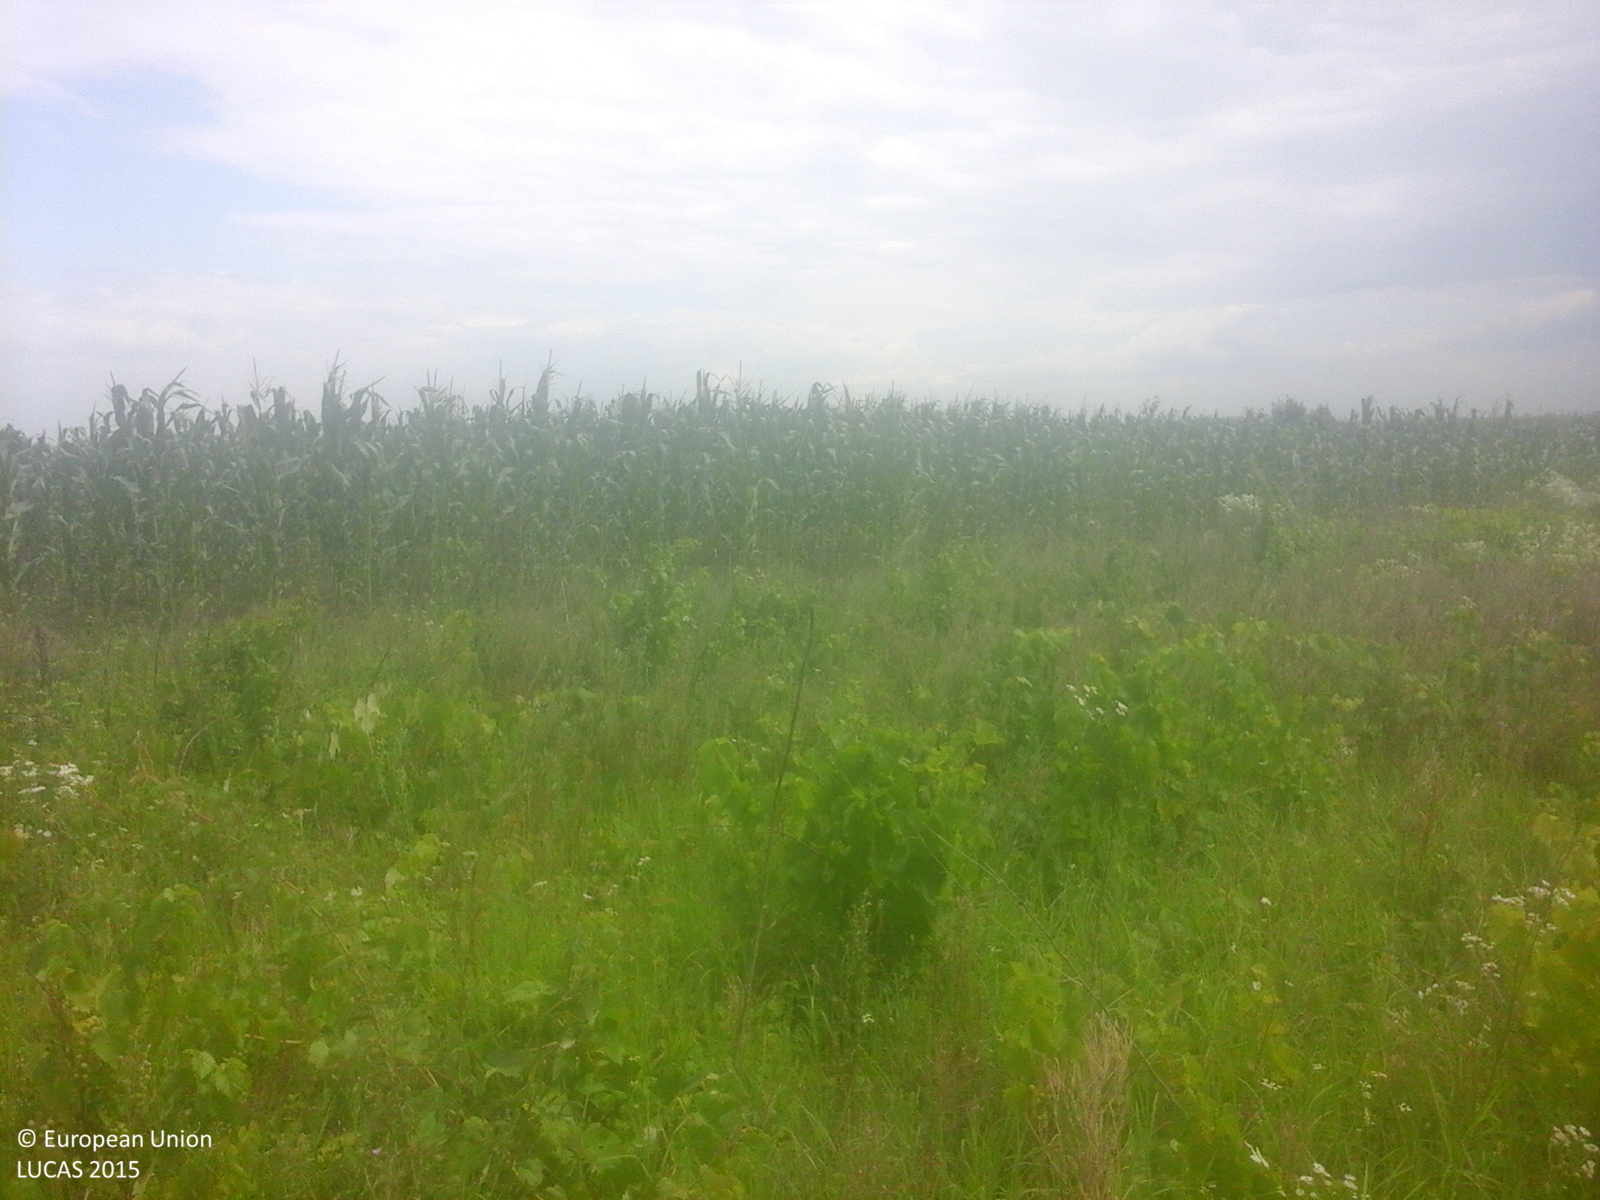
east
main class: Cropland
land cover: Vineyards
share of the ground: 50 - 75 %
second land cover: Spontaneously vegetated surfaces
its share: 50 - 75 %
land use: Abandoned areas
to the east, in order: Vineyards; Spontaneously vegetated surfaces; Maize; Vineyards; Grass margins; Maize; Nuts trees; Lucerne; Vineyards; Common wheat; Grass margins; Tracks; Grass margins; Maize; Common wheat; Maize; Common wheat; Maize
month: July
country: RO
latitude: 44.1451
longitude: 25.5281
